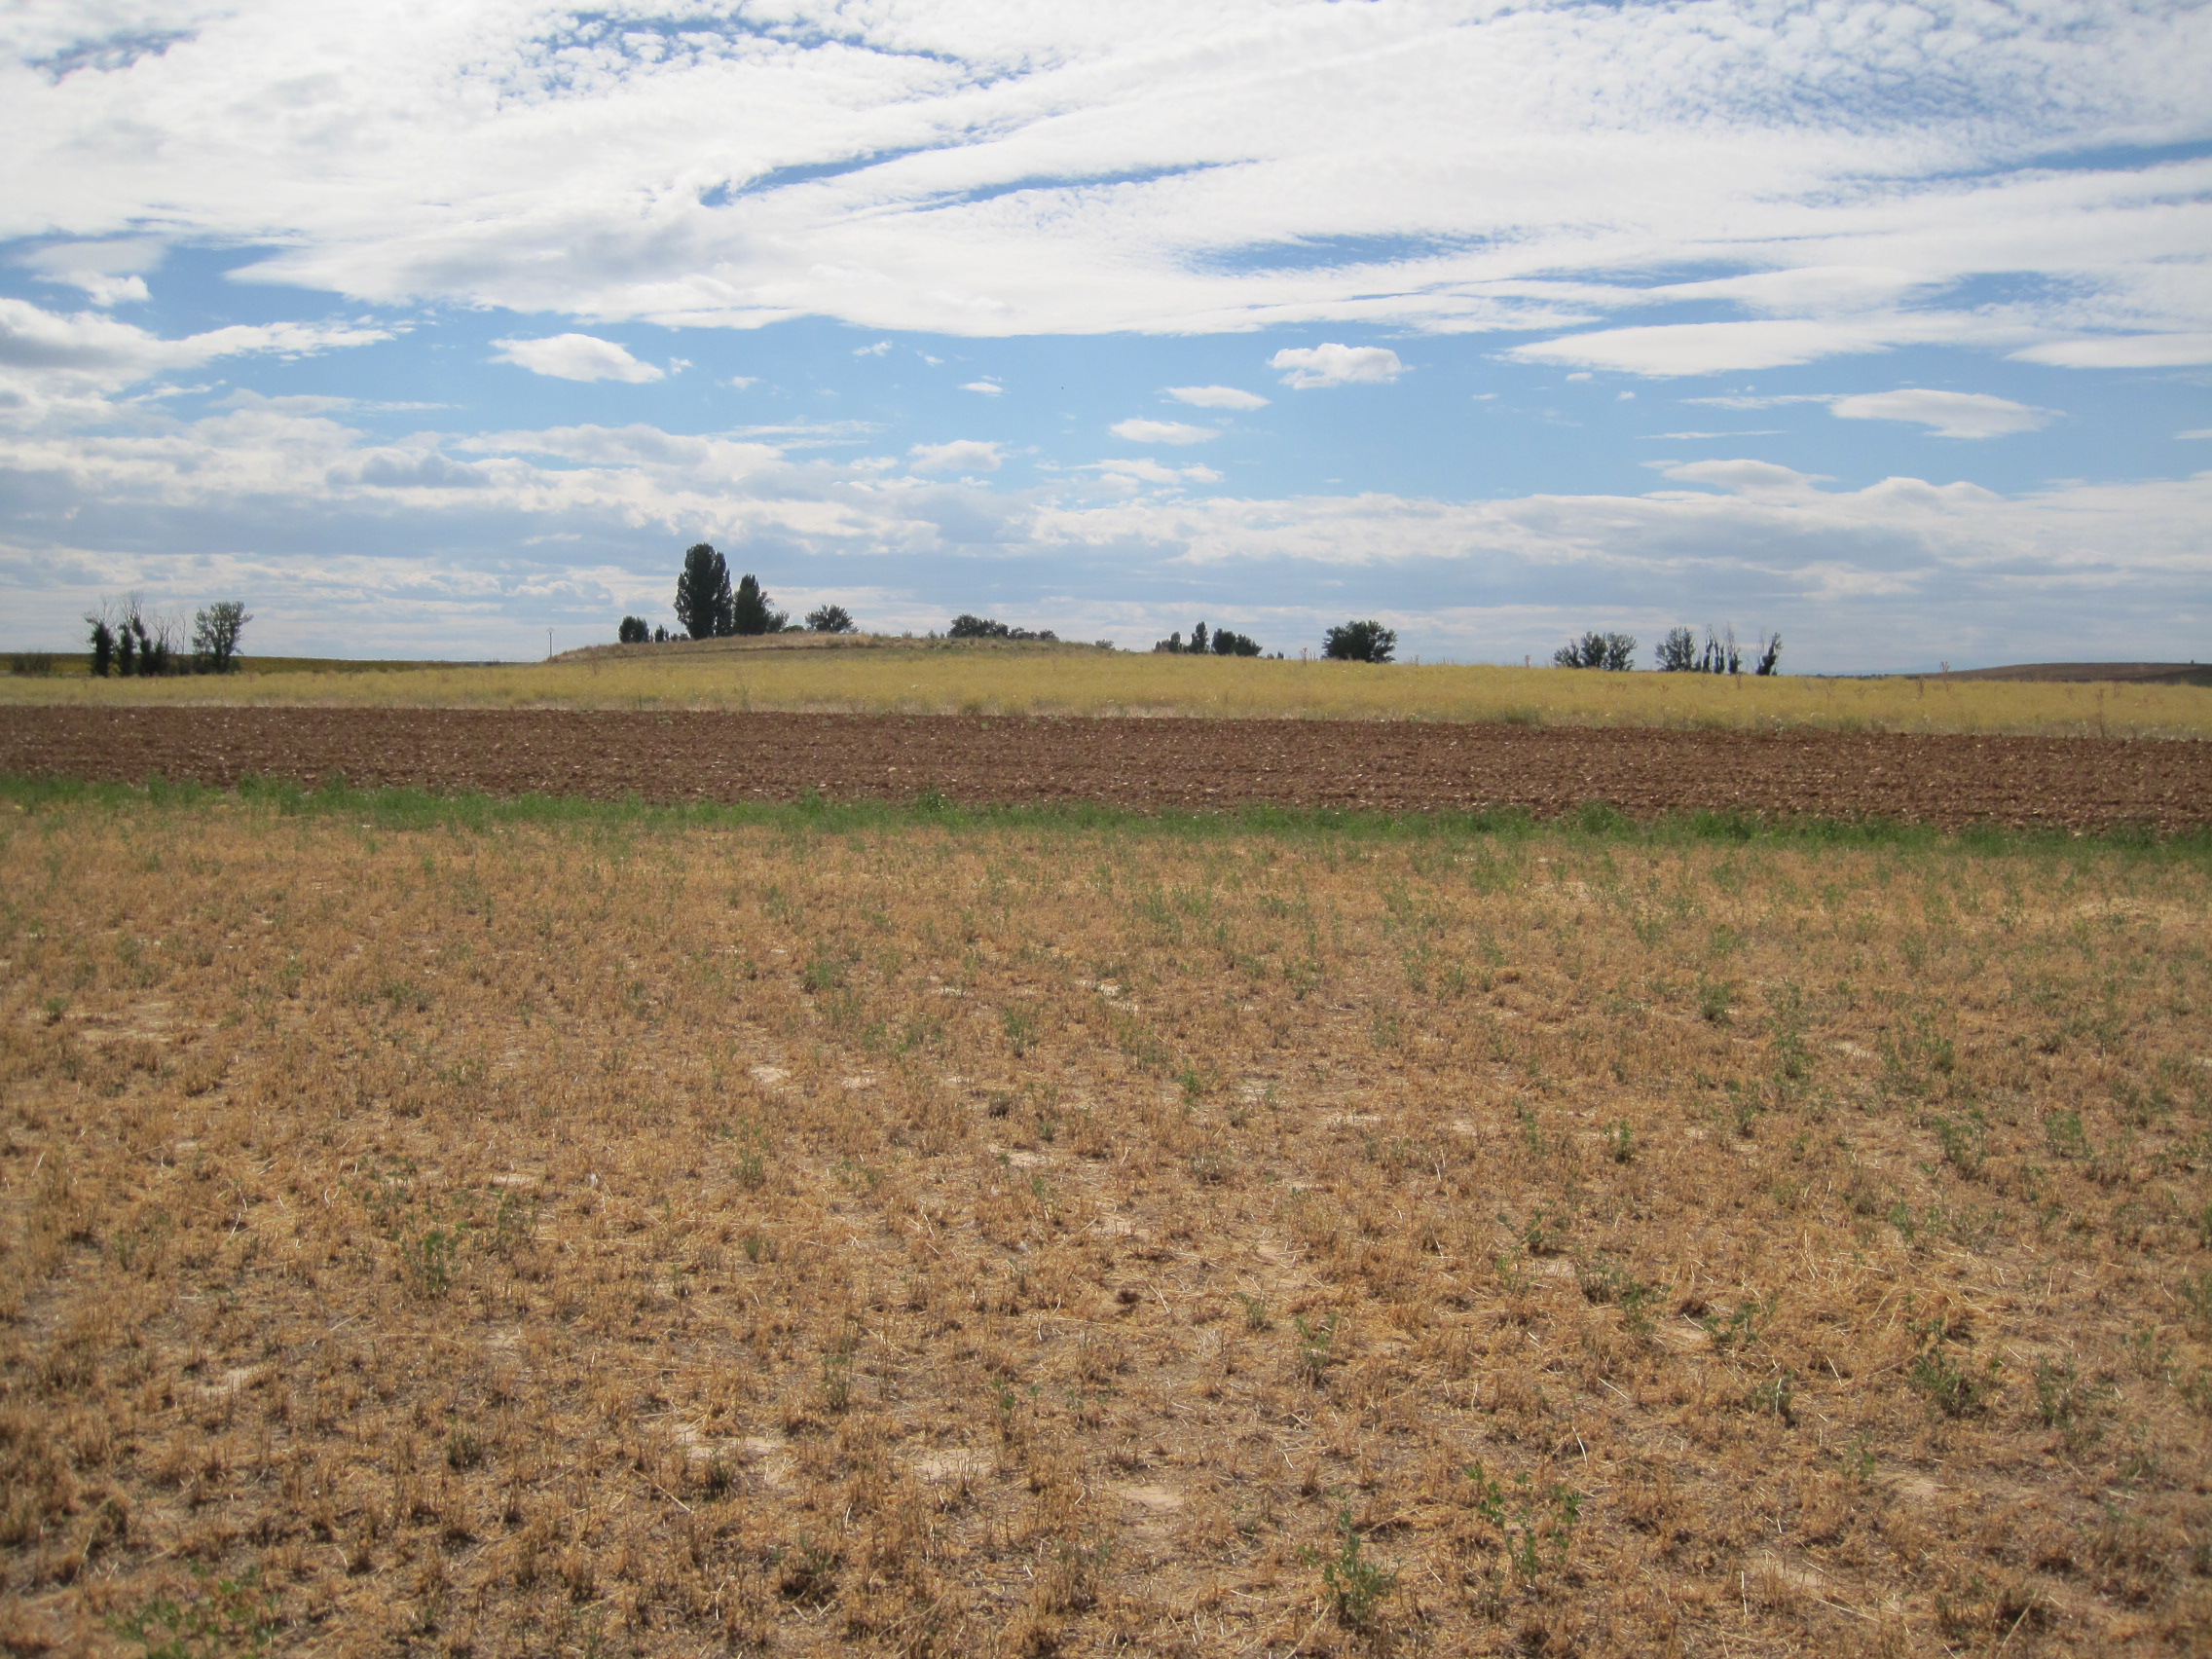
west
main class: Cropland
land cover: Lucerne
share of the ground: 25 - 50 %
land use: Agriculture (excluding fallow land and kitchen gardens)
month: July
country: ES
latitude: 42.0449
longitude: -5.4675
